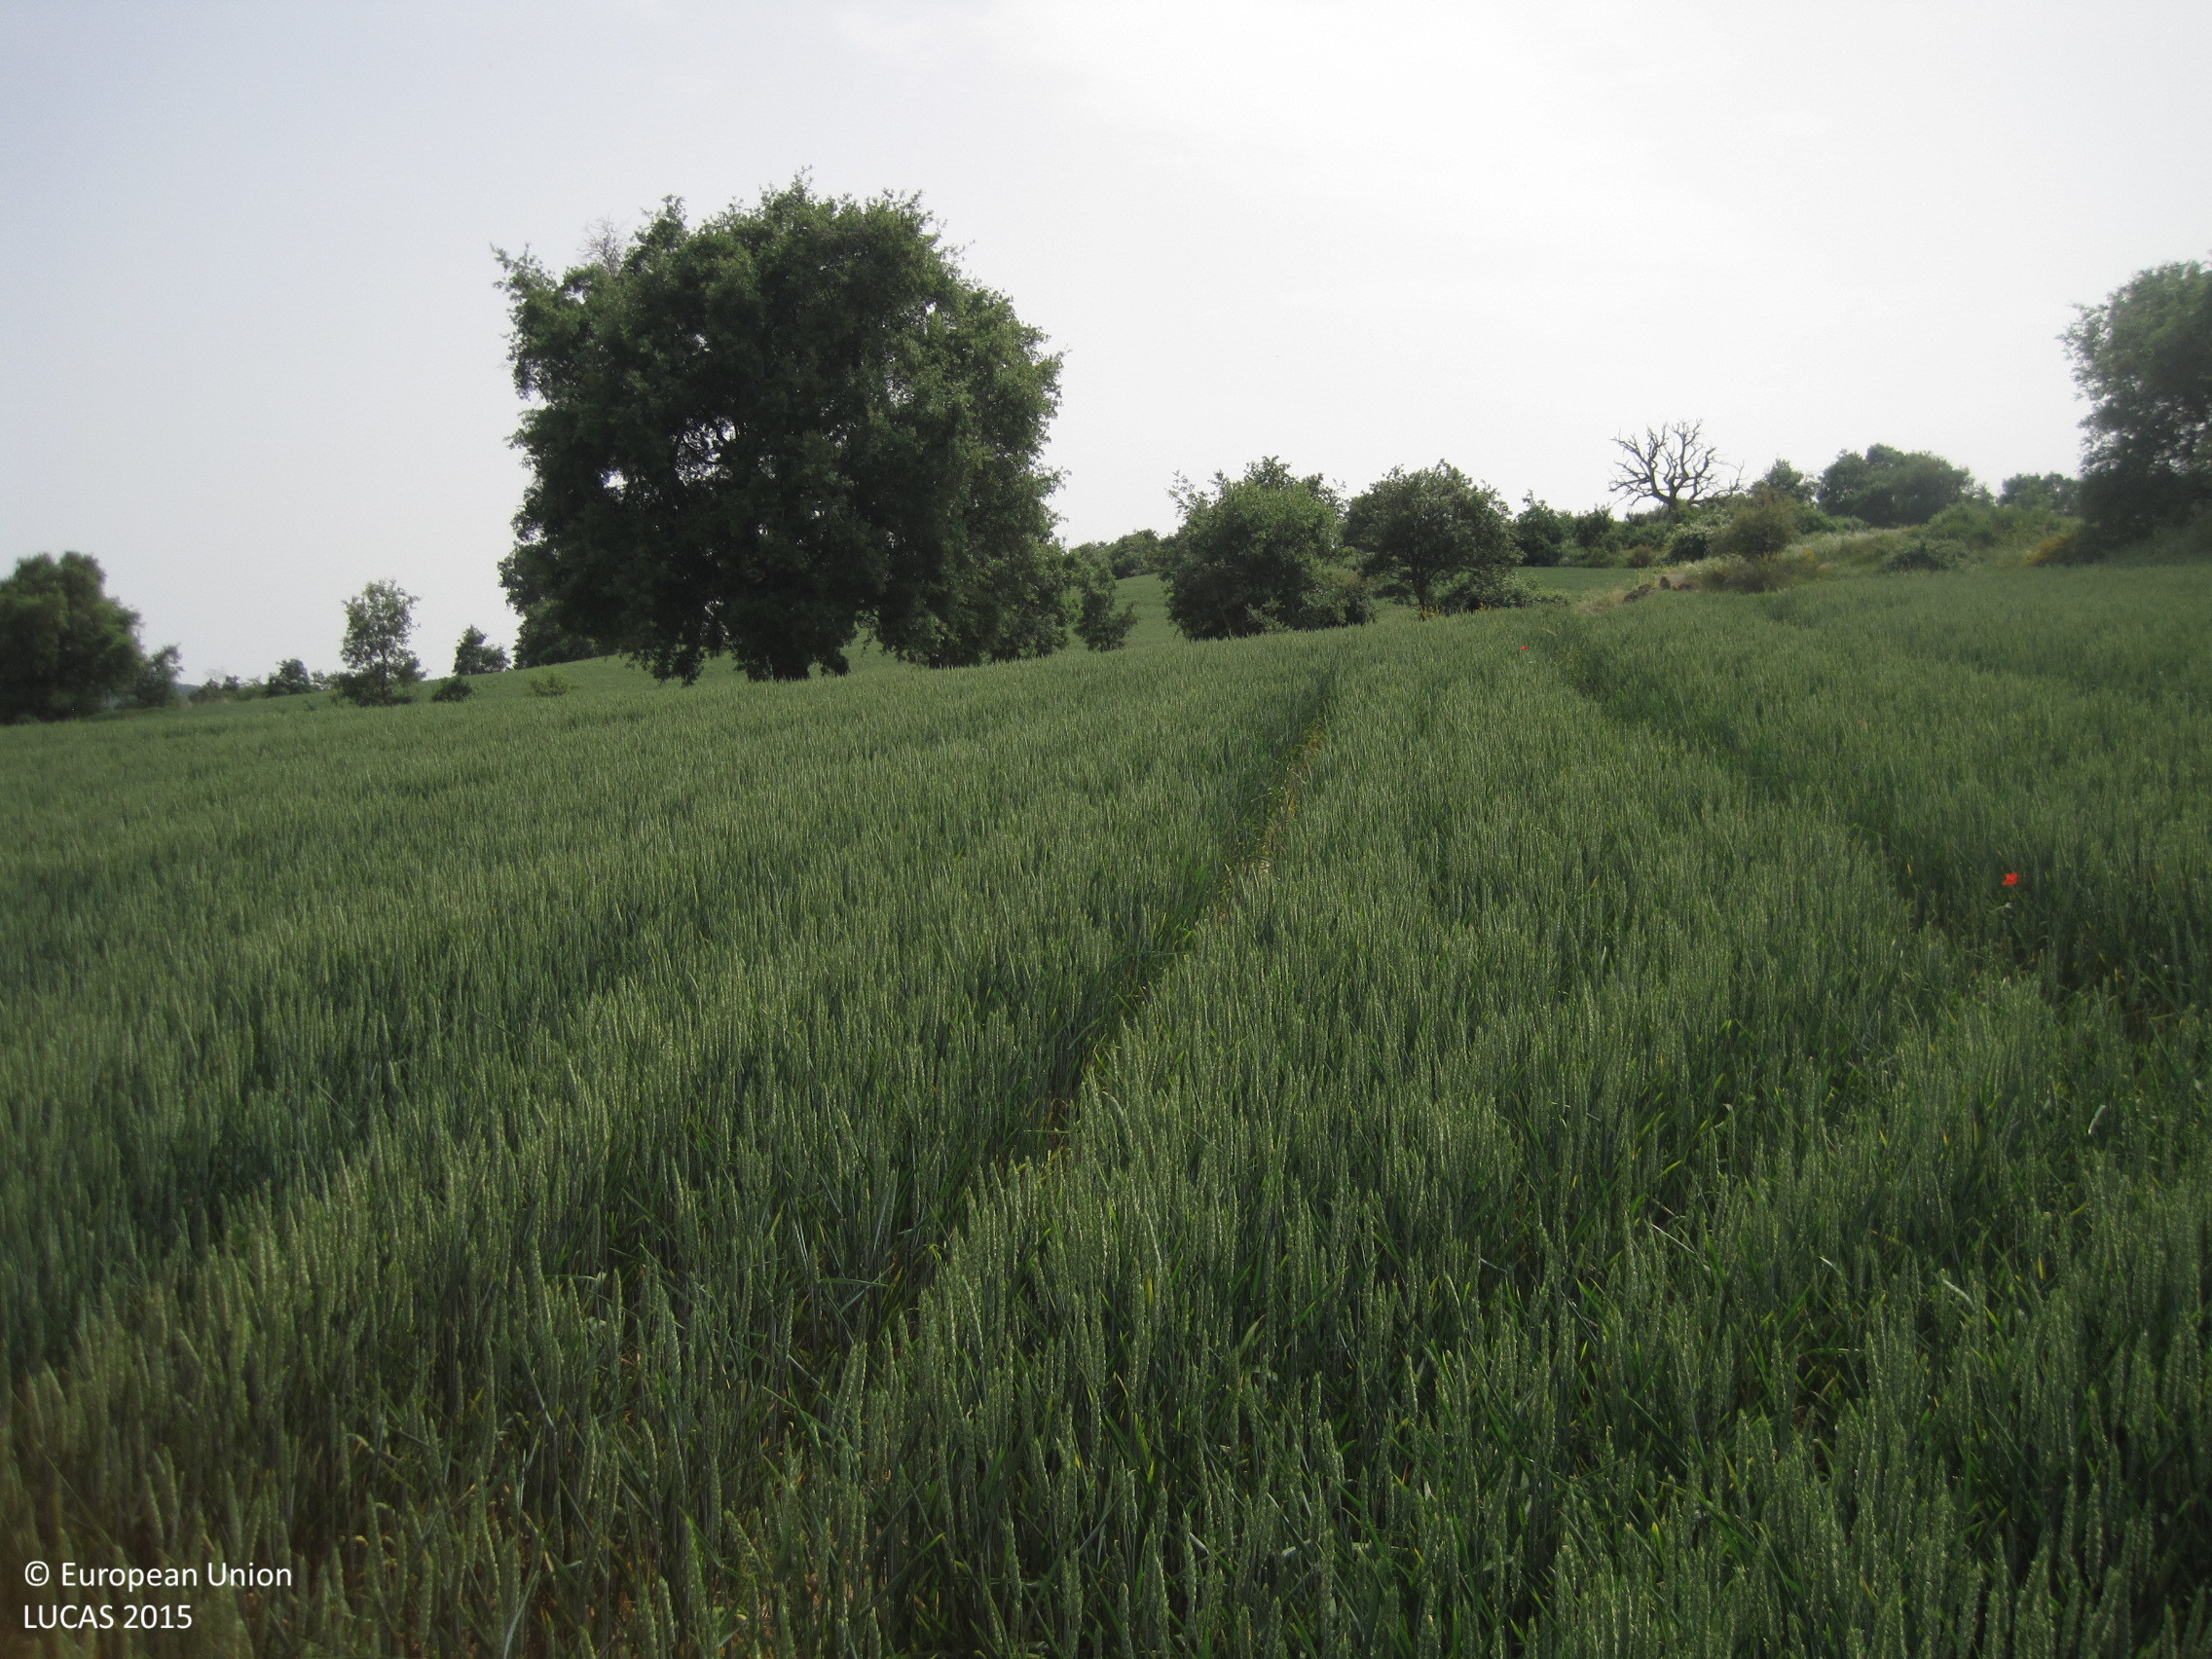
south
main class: Cropland
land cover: Common wheat
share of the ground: > 75 %
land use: Agriculture (excluding fallow land and kitchen gardens)
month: May
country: ES
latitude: 42.5960
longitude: -1.6762
